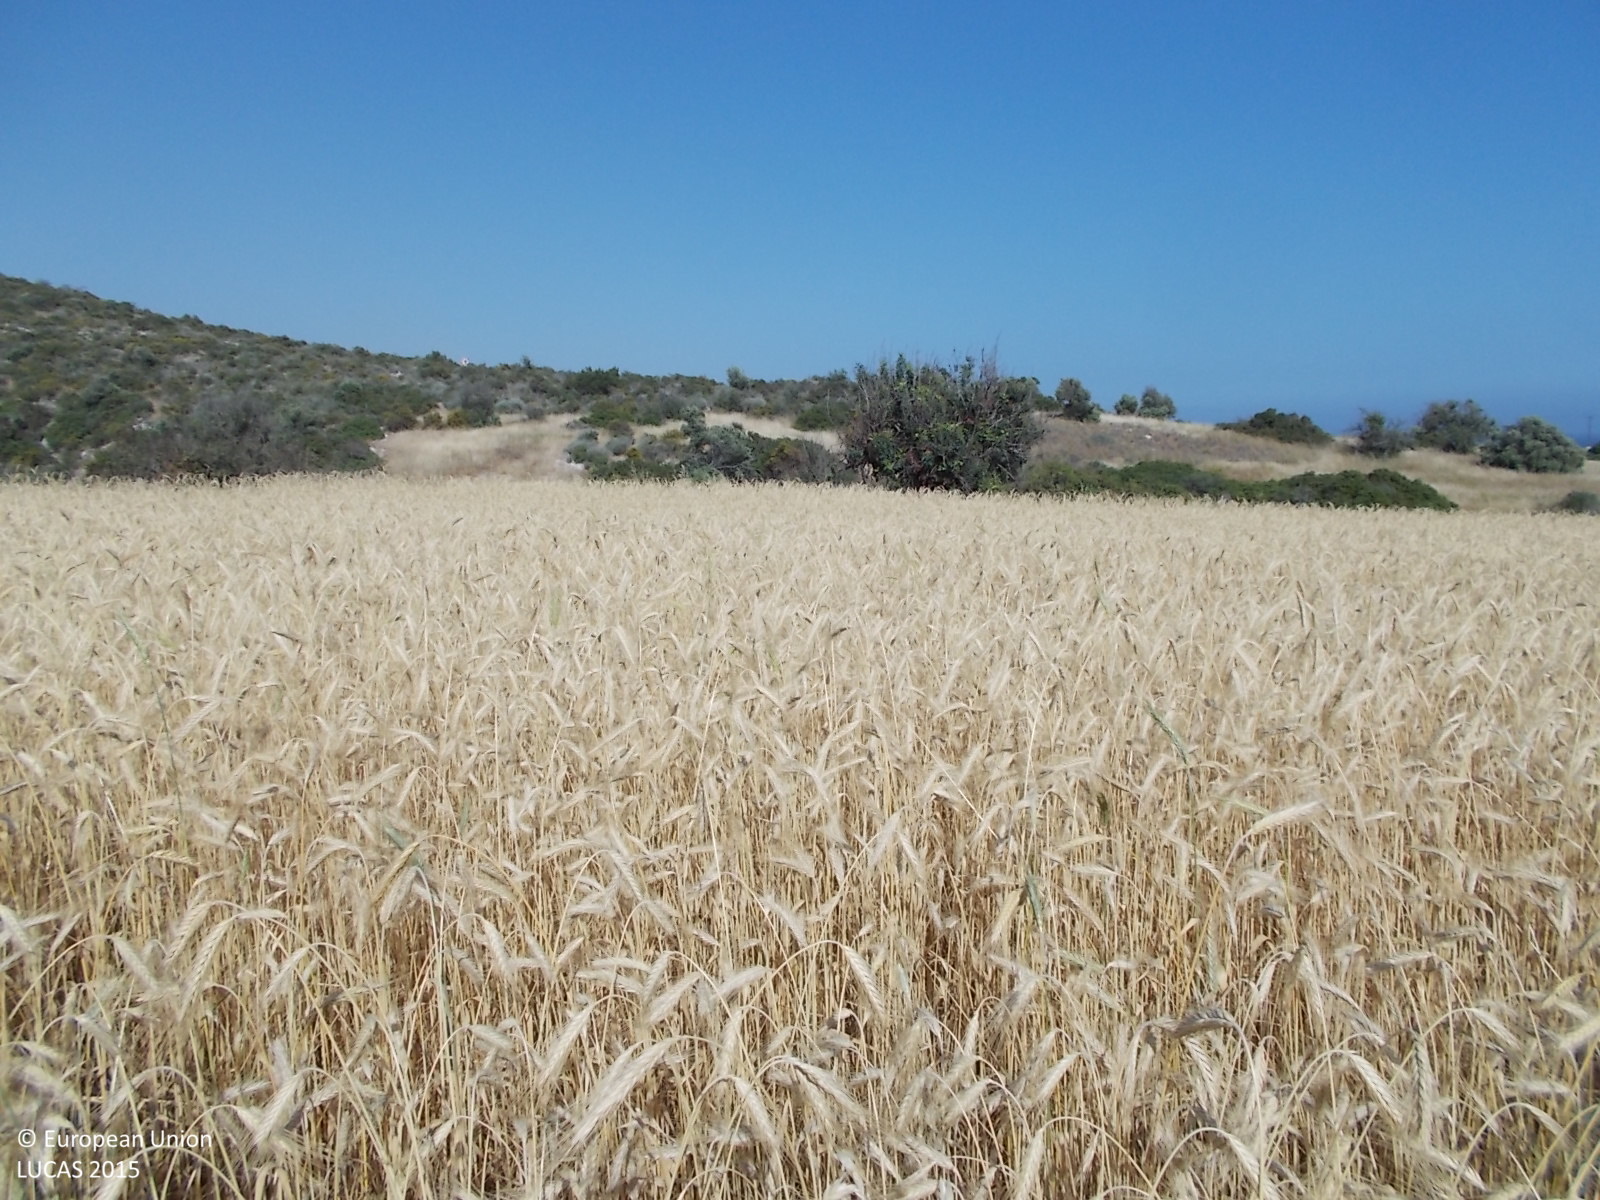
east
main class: Cropland
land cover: Common wheat
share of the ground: > 75 %
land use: Agriculture (excluding fallow land and kitchen gardens)
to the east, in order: Common wheat; Grassland with sparse tree/shrub cover; Common wheat; Broadleaved woodland; Shrubland with sparse tree cover; Shrubland without tree cover; Paved roads, cycling and walking lanes
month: April
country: CY
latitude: 34.7241
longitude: 33.2715
